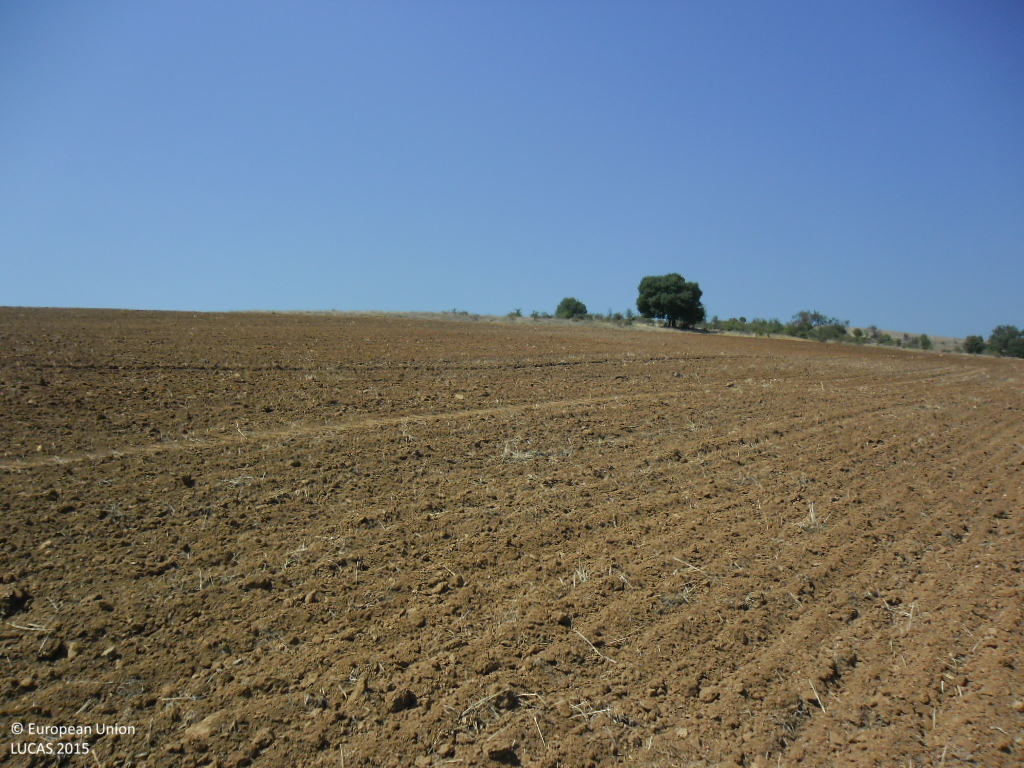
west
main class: Cropland
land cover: Common wheat
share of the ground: < 10 %
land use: Agriculture (excluding fallow land and kitchen gardens)
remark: Harvested field
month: August
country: BG
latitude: 42.0012
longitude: 22.9524
